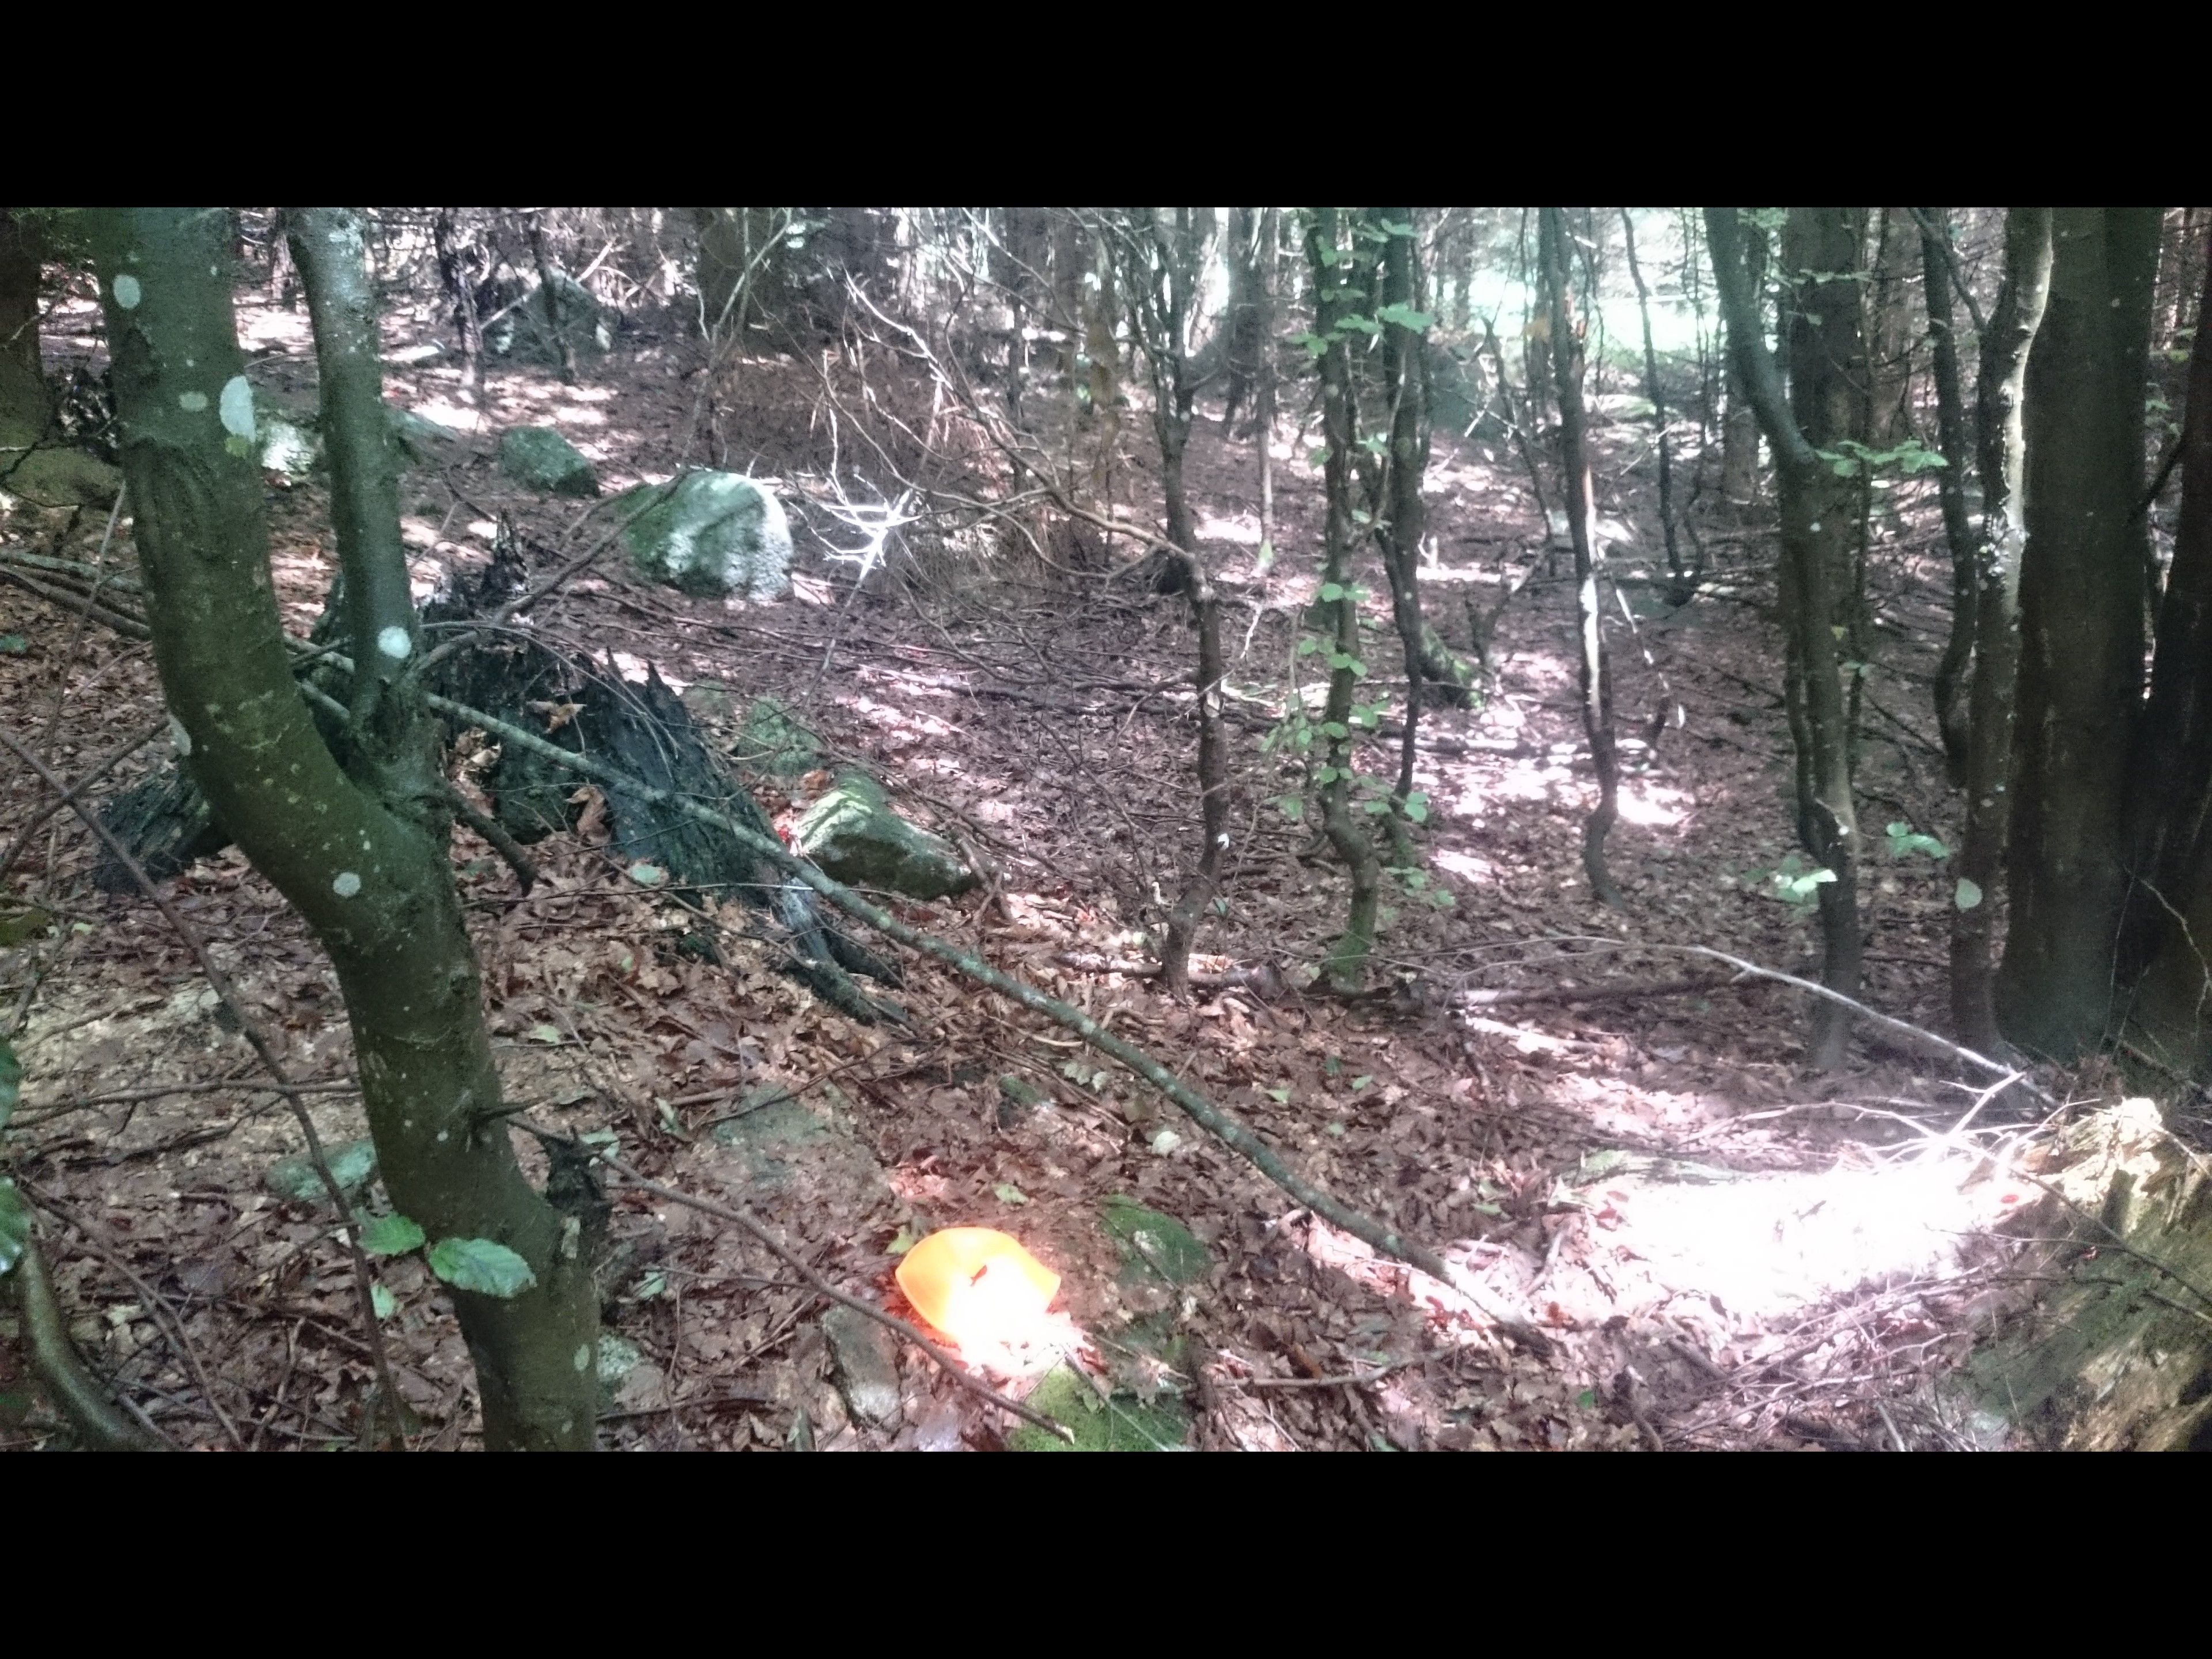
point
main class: Woodland
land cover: Spruce dominated mixed woodland
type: hemiboreal forest and nemoral coniferous forest and mixed broadleaved-coniferous forest
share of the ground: > 75 %
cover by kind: coniferous forest trees 65 %, broadleaved forest trees 30 %, unconsolidated bare surface 5 %
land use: Forestry
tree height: > 5 m
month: June
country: AT
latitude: 48.6444
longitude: 14.7380
